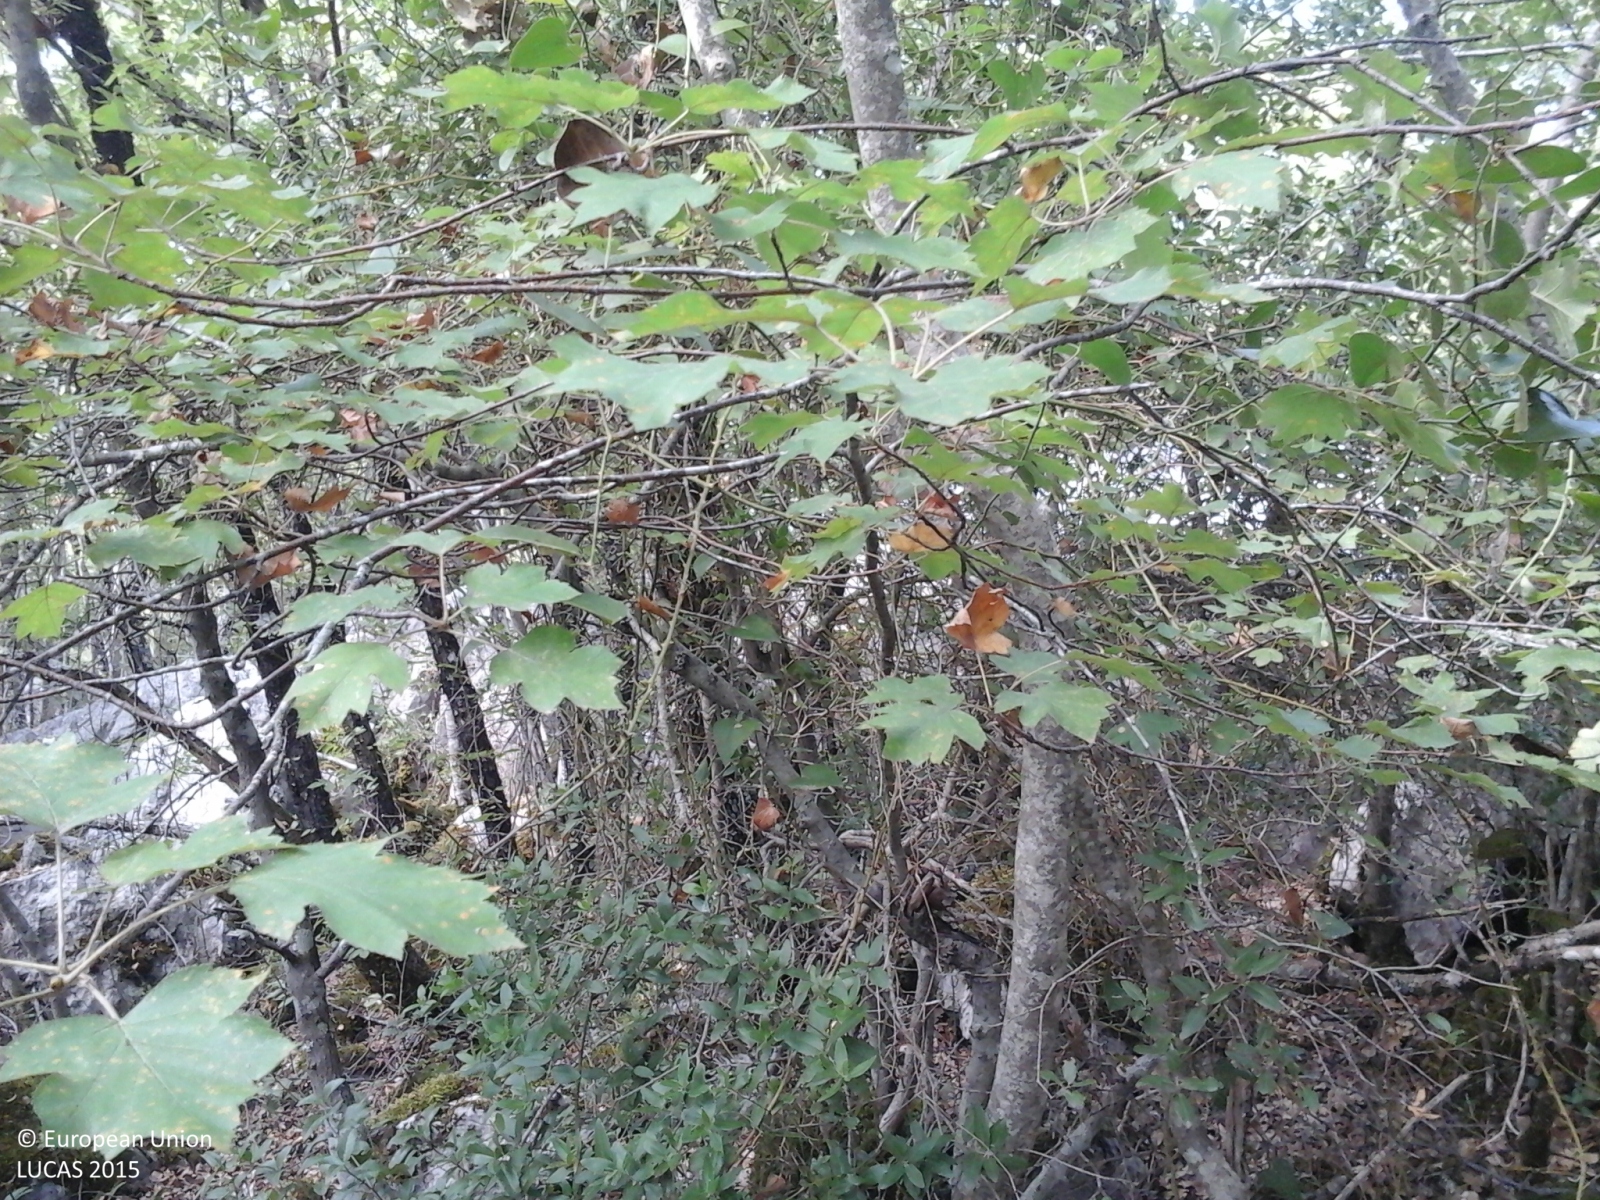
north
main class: Woodland
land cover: Broadleaved woodland
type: thermophilous deciduous forest
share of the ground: > 75 %
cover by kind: broadleaved forest trees 90 %, shrubs 10 %
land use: Forestry
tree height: < 5 m
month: August
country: IT
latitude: 42.6630
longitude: 12.3471
